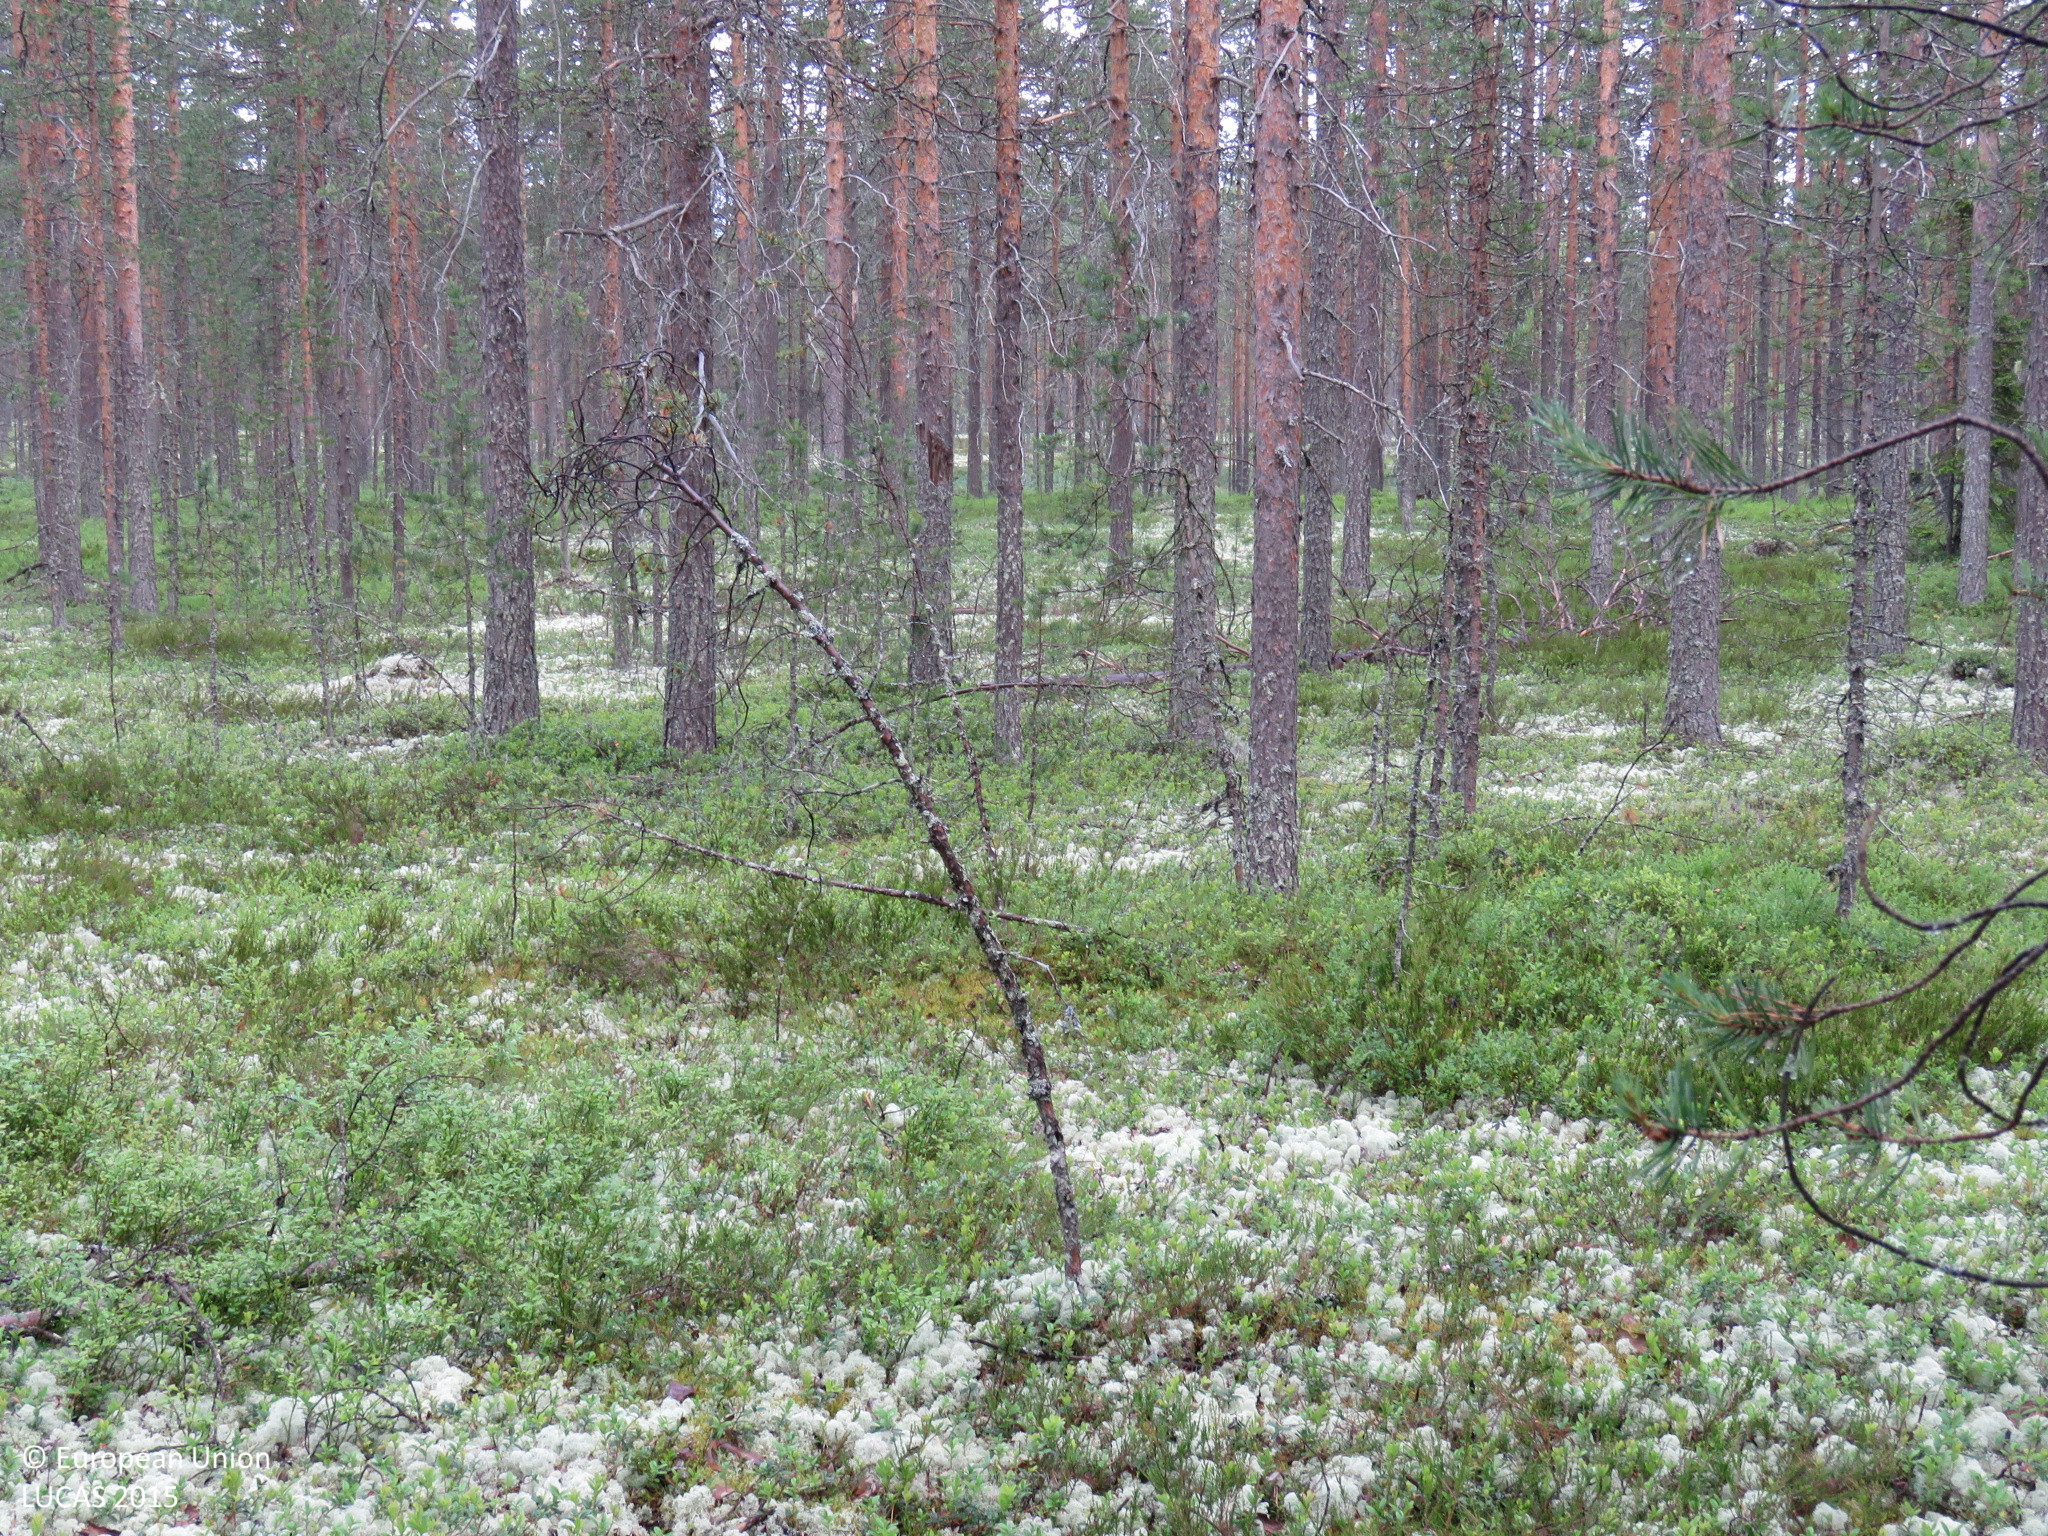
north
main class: Woodland
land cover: Pine dominated coniferous woodland
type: boreal forest
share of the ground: > 75 %
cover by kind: coniferous forest trees 75 %, lichens and mosses 15 %, shrubs 10 %
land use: Forestry
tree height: > 5 m
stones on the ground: < 10 %
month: July
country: FI
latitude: 64.5082
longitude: 26.6748
